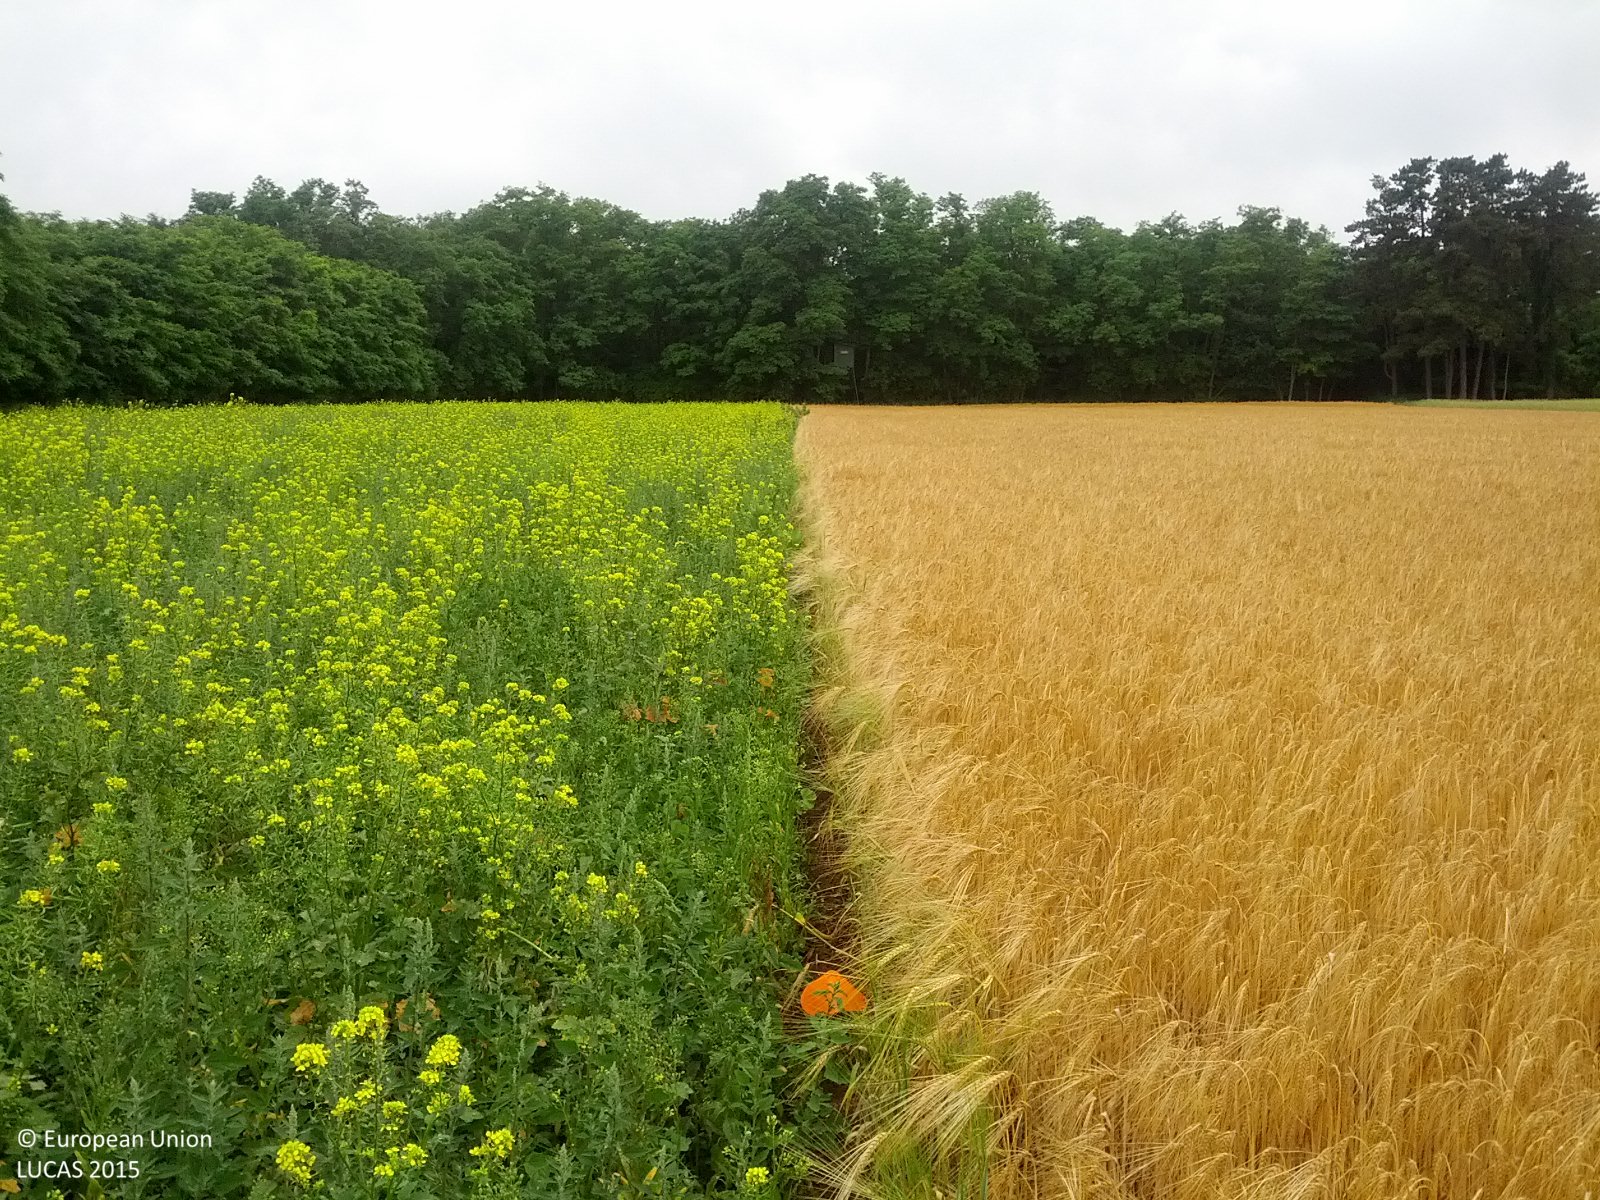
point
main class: Cropland
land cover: Barley
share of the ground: > 75 %
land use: Agriculture (excluding fallow land and kitchen gardens)
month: June
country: AT
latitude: 48.3032
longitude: 16.7881
